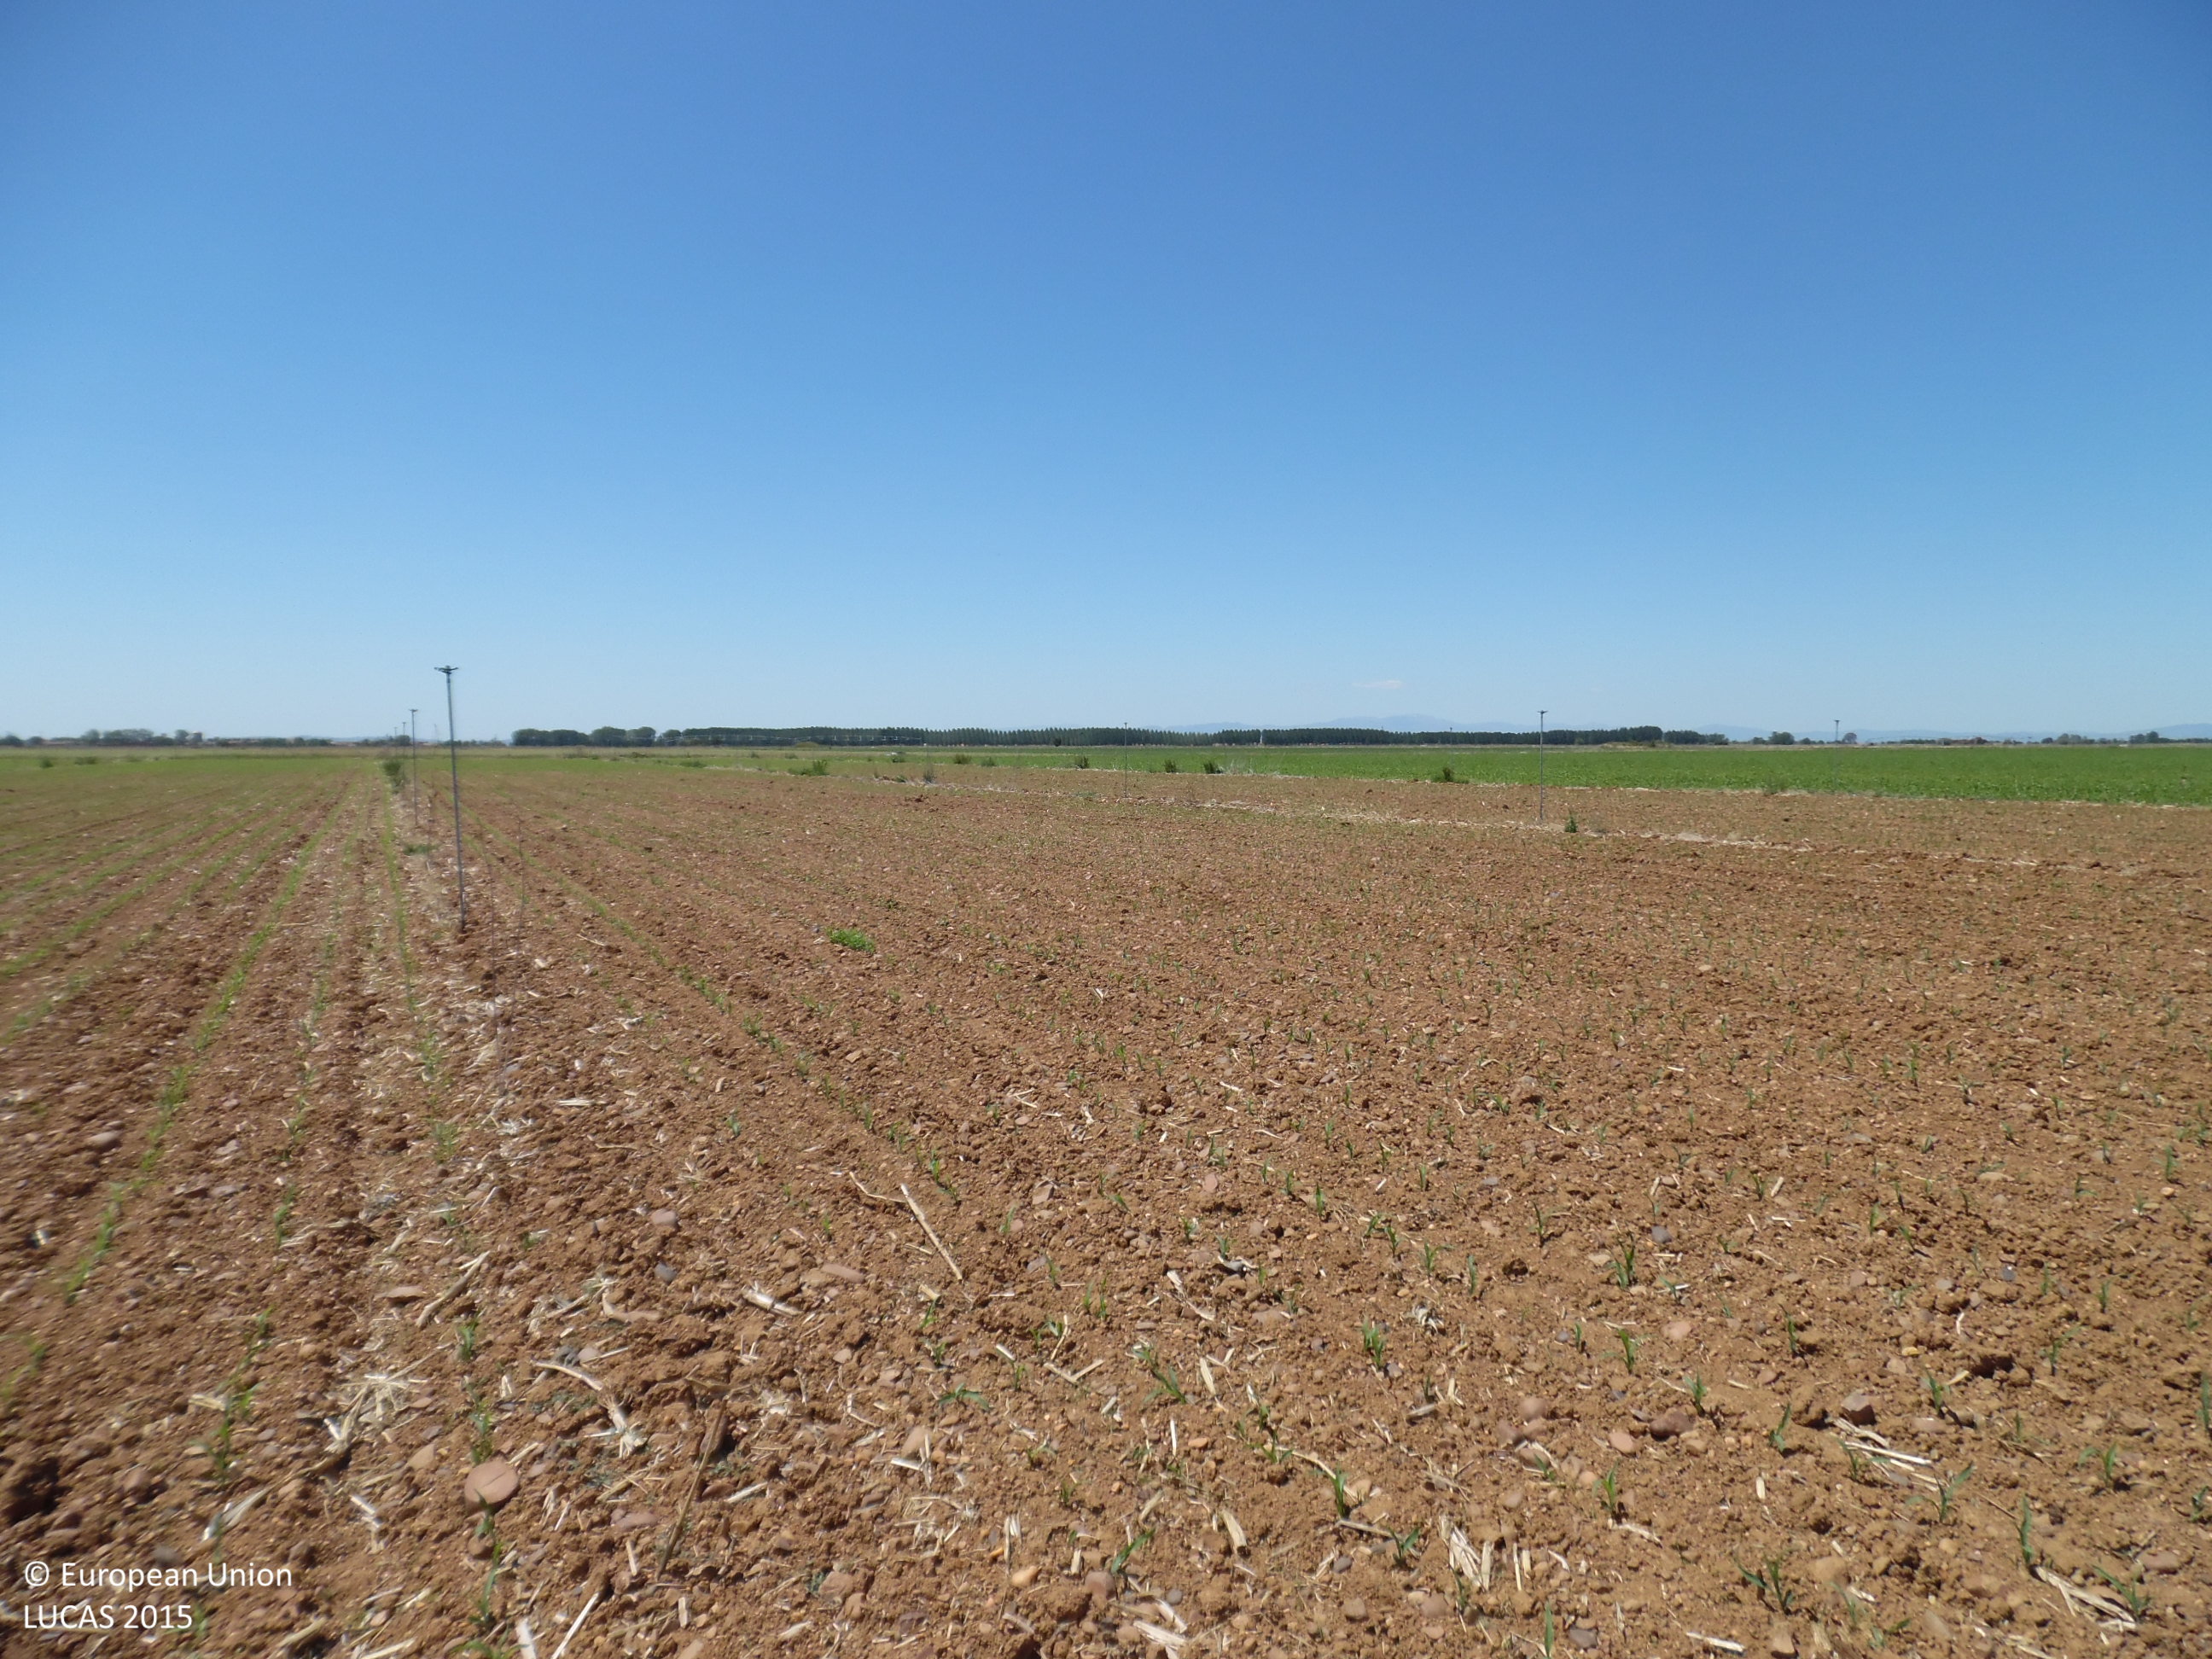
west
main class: Cropland
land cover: Maize
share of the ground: < 10 %
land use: Agriculture (excluding fallow land and kitchen gardens)
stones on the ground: 10 - 25 %
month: June
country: ES
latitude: 42.3965
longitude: -5.6835
